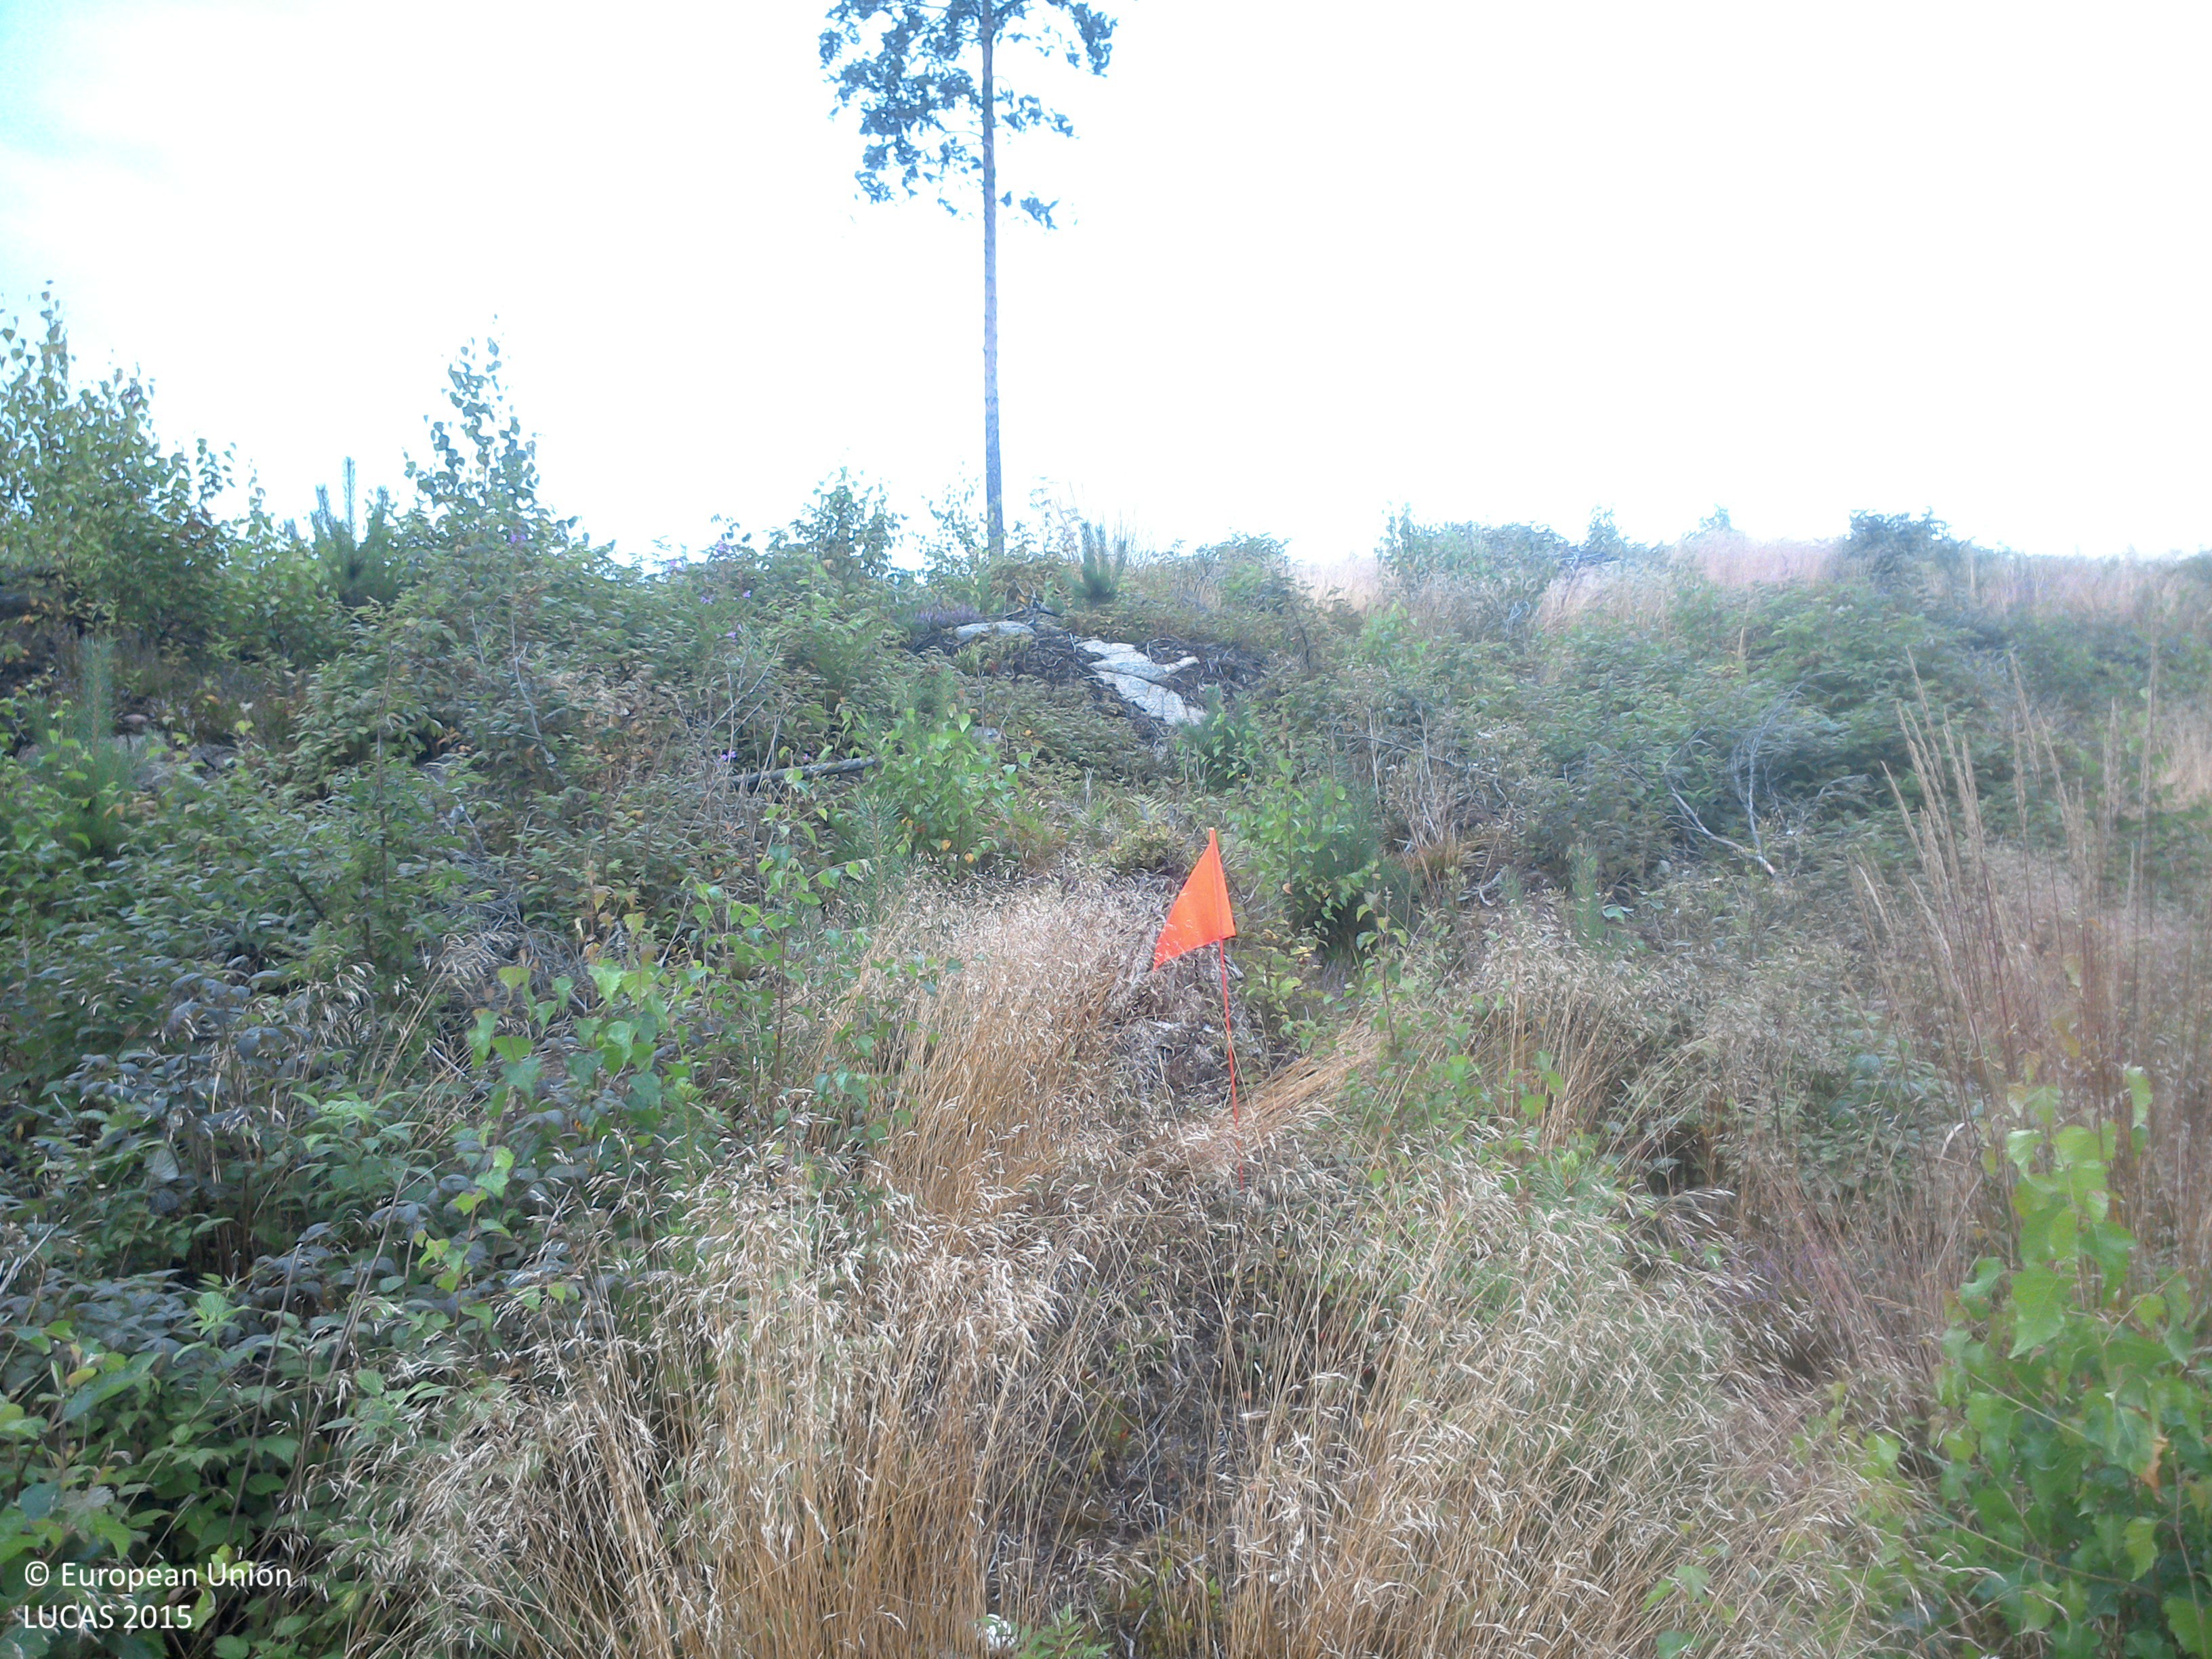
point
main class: Shrubland
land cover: Shrubland with sparse tree cover
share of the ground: 50 - 75 %
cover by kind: shrubs 60 %, herbaceous plants 35 %, coniferous forest trees 5 %
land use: Forestry
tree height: < 5 m
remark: Clear cut
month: August
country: SE
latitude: 57.7191
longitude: 15.2841
